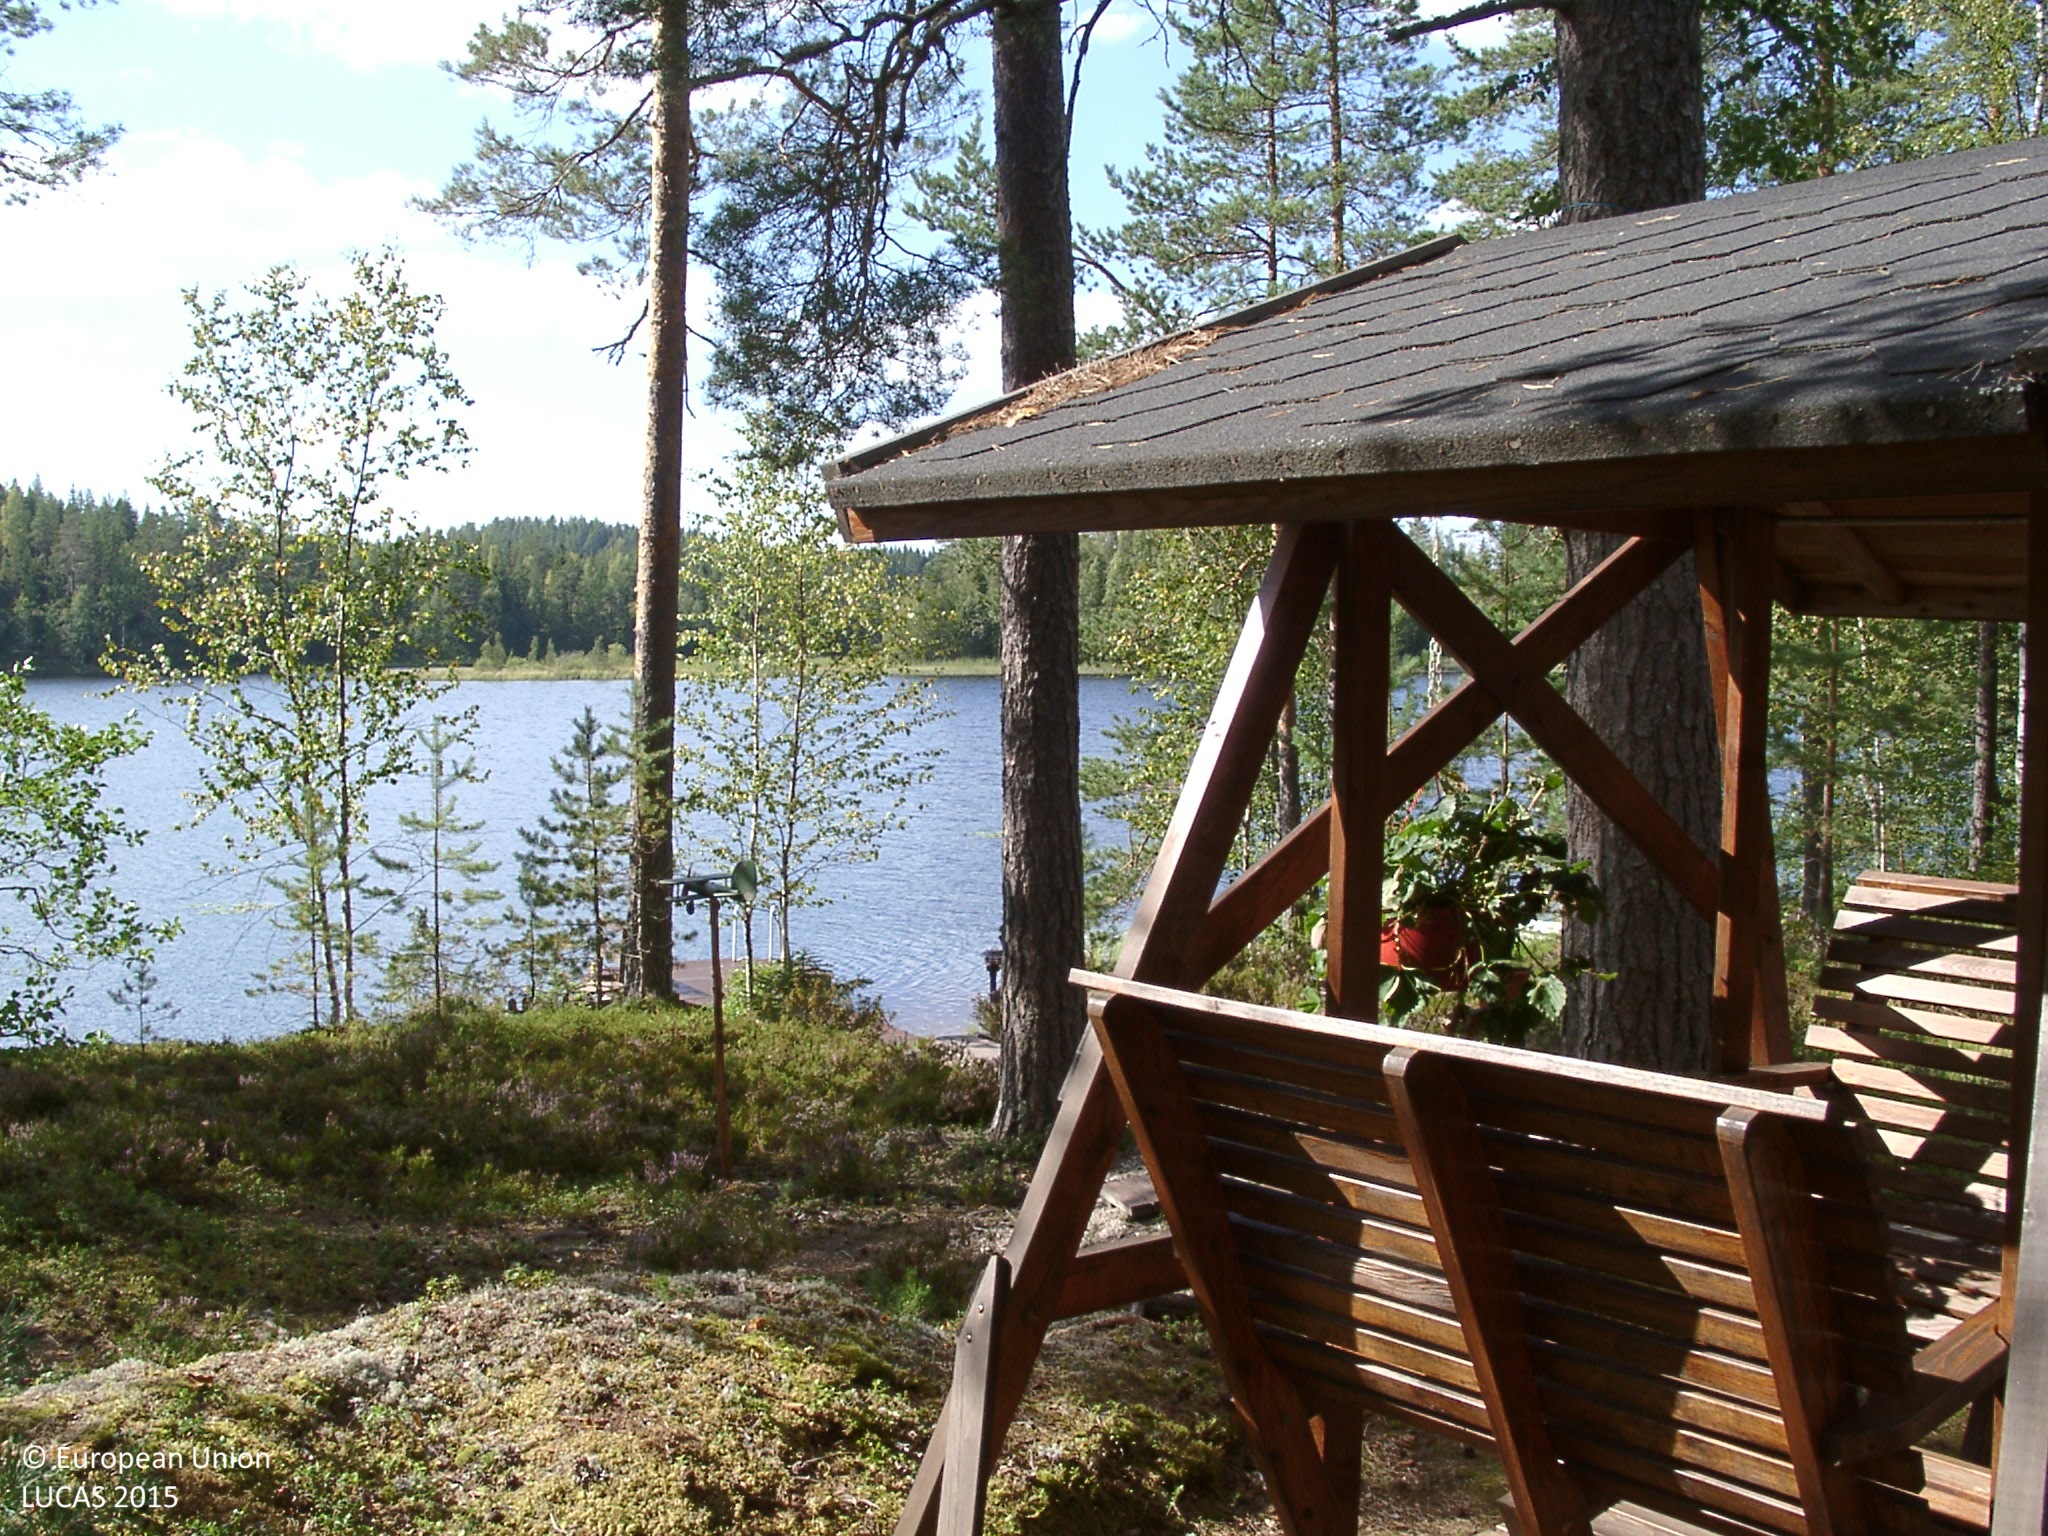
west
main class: Woodland
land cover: Pine dominated mixed woodland
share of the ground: 50 - 75 %
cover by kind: coniferous forest trees 40 %, shrubs 30 %, broadleaved forest trees 20 %, lichens and mosses 10 %
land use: Residential
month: August
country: FI
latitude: 61.8110
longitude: 24.8868
